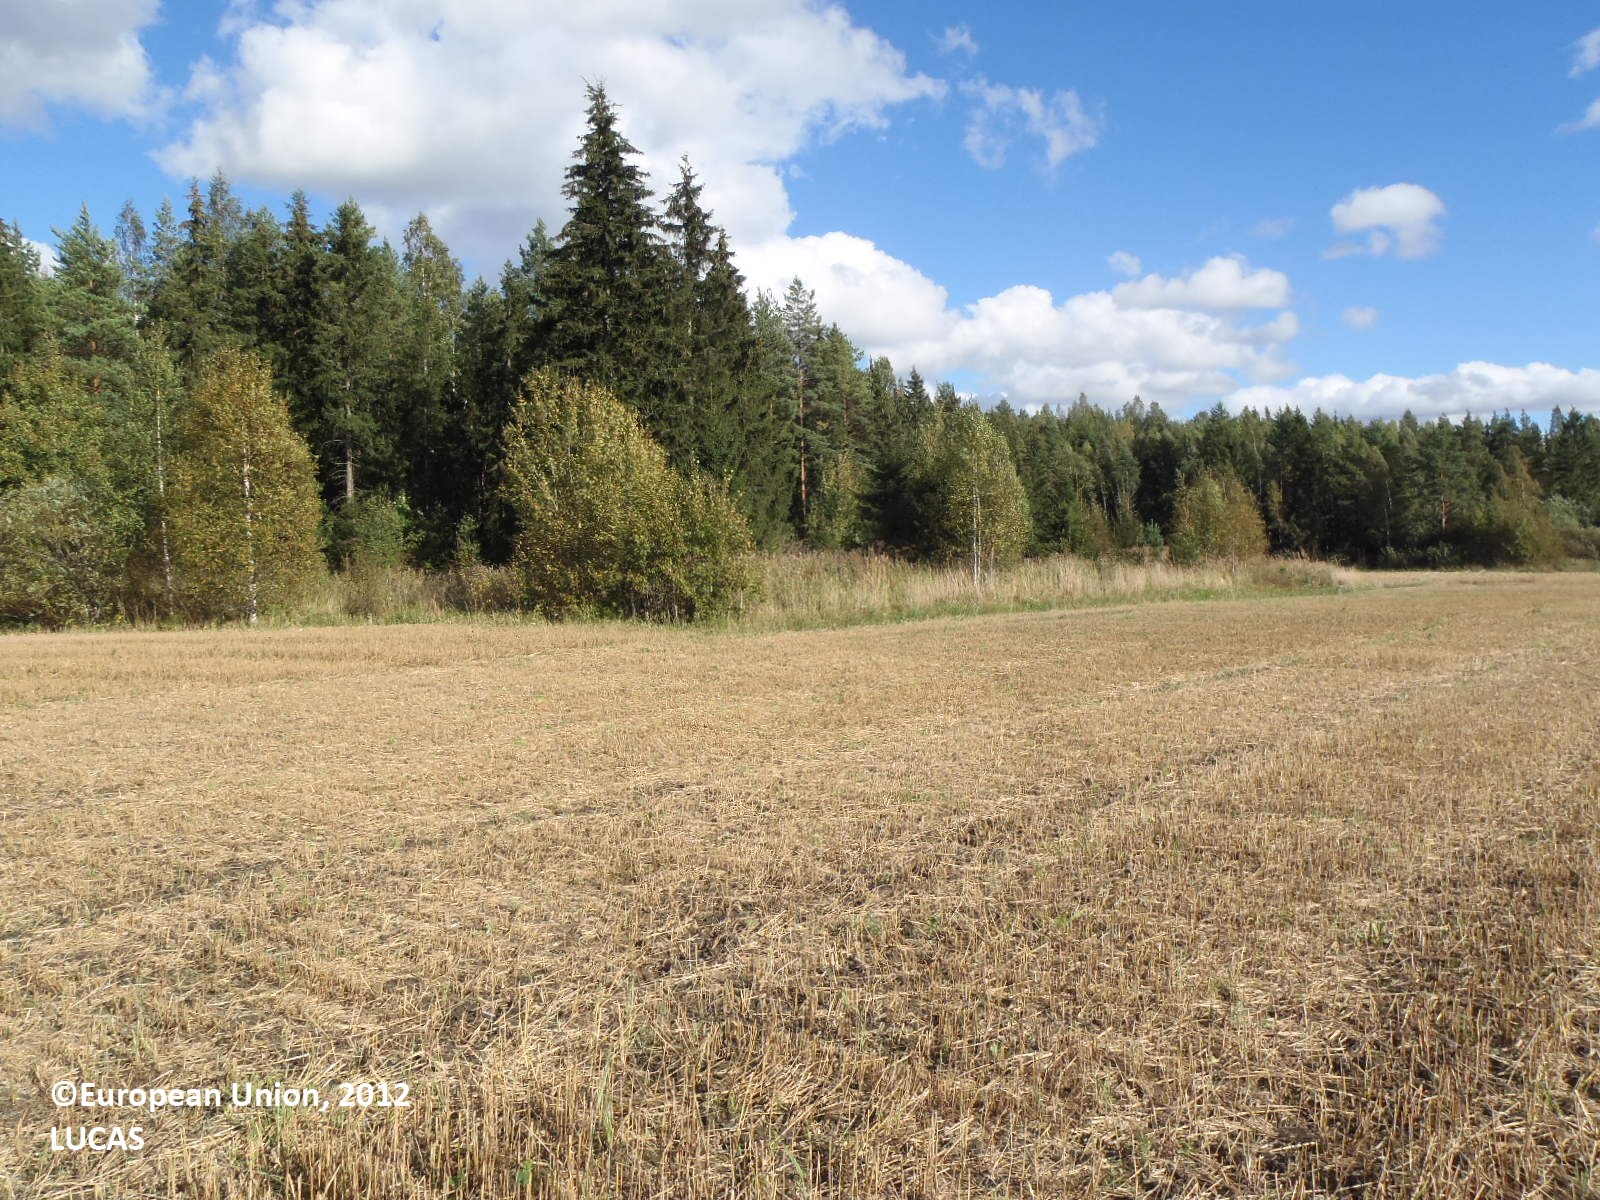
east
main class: Cropland
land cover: Barley
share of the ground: 50 - 75 %
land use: Agriculture (excluding fallow land and kitchen gardens)
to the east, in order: Barley; Grassland without tree/shrub cover; Spruce dominated coniferous woodland; Spruce dominated mixed woodland
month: September
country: FI
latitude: 61.2867
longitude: 22.4729
